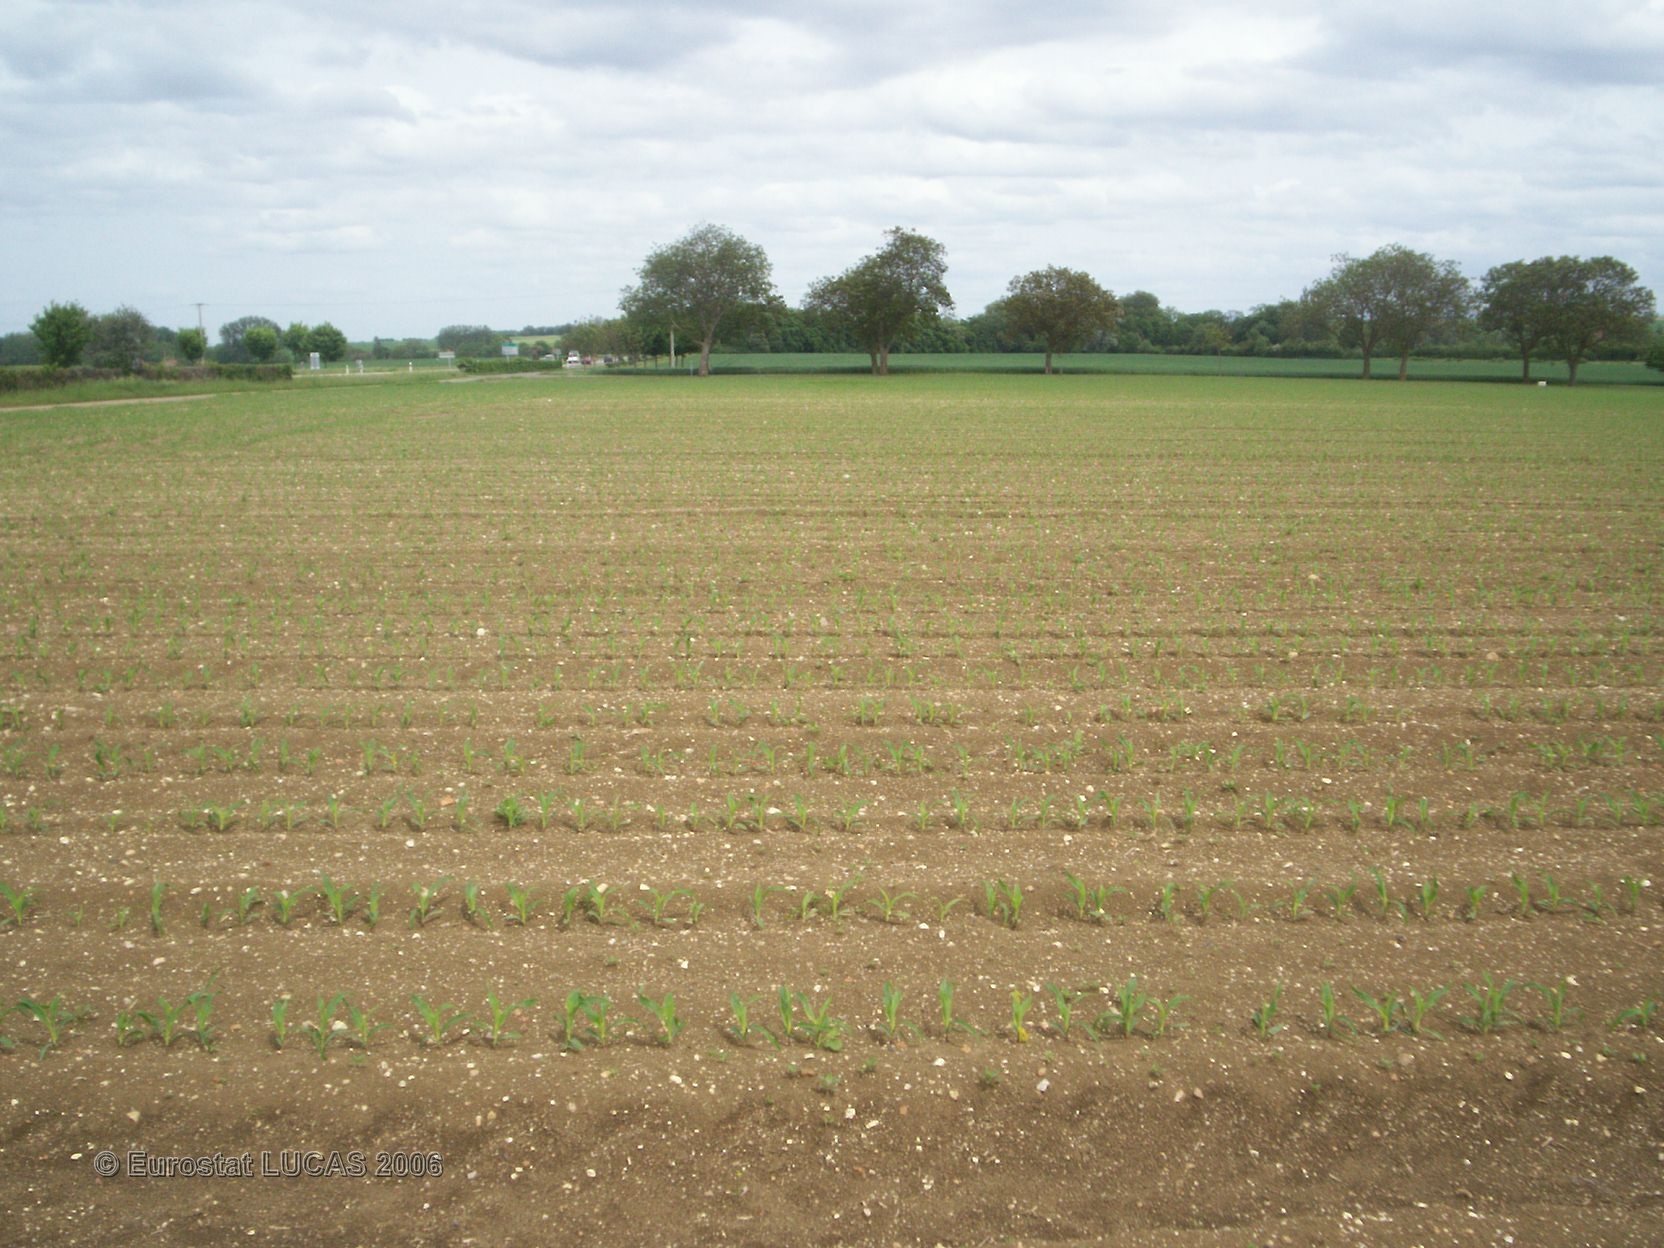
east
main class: Cropland
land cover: Maize
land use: Agriculture (excluding fallow land and kitchen gardens)
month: May
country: FR
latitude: 46.1007
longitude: 3.2337
